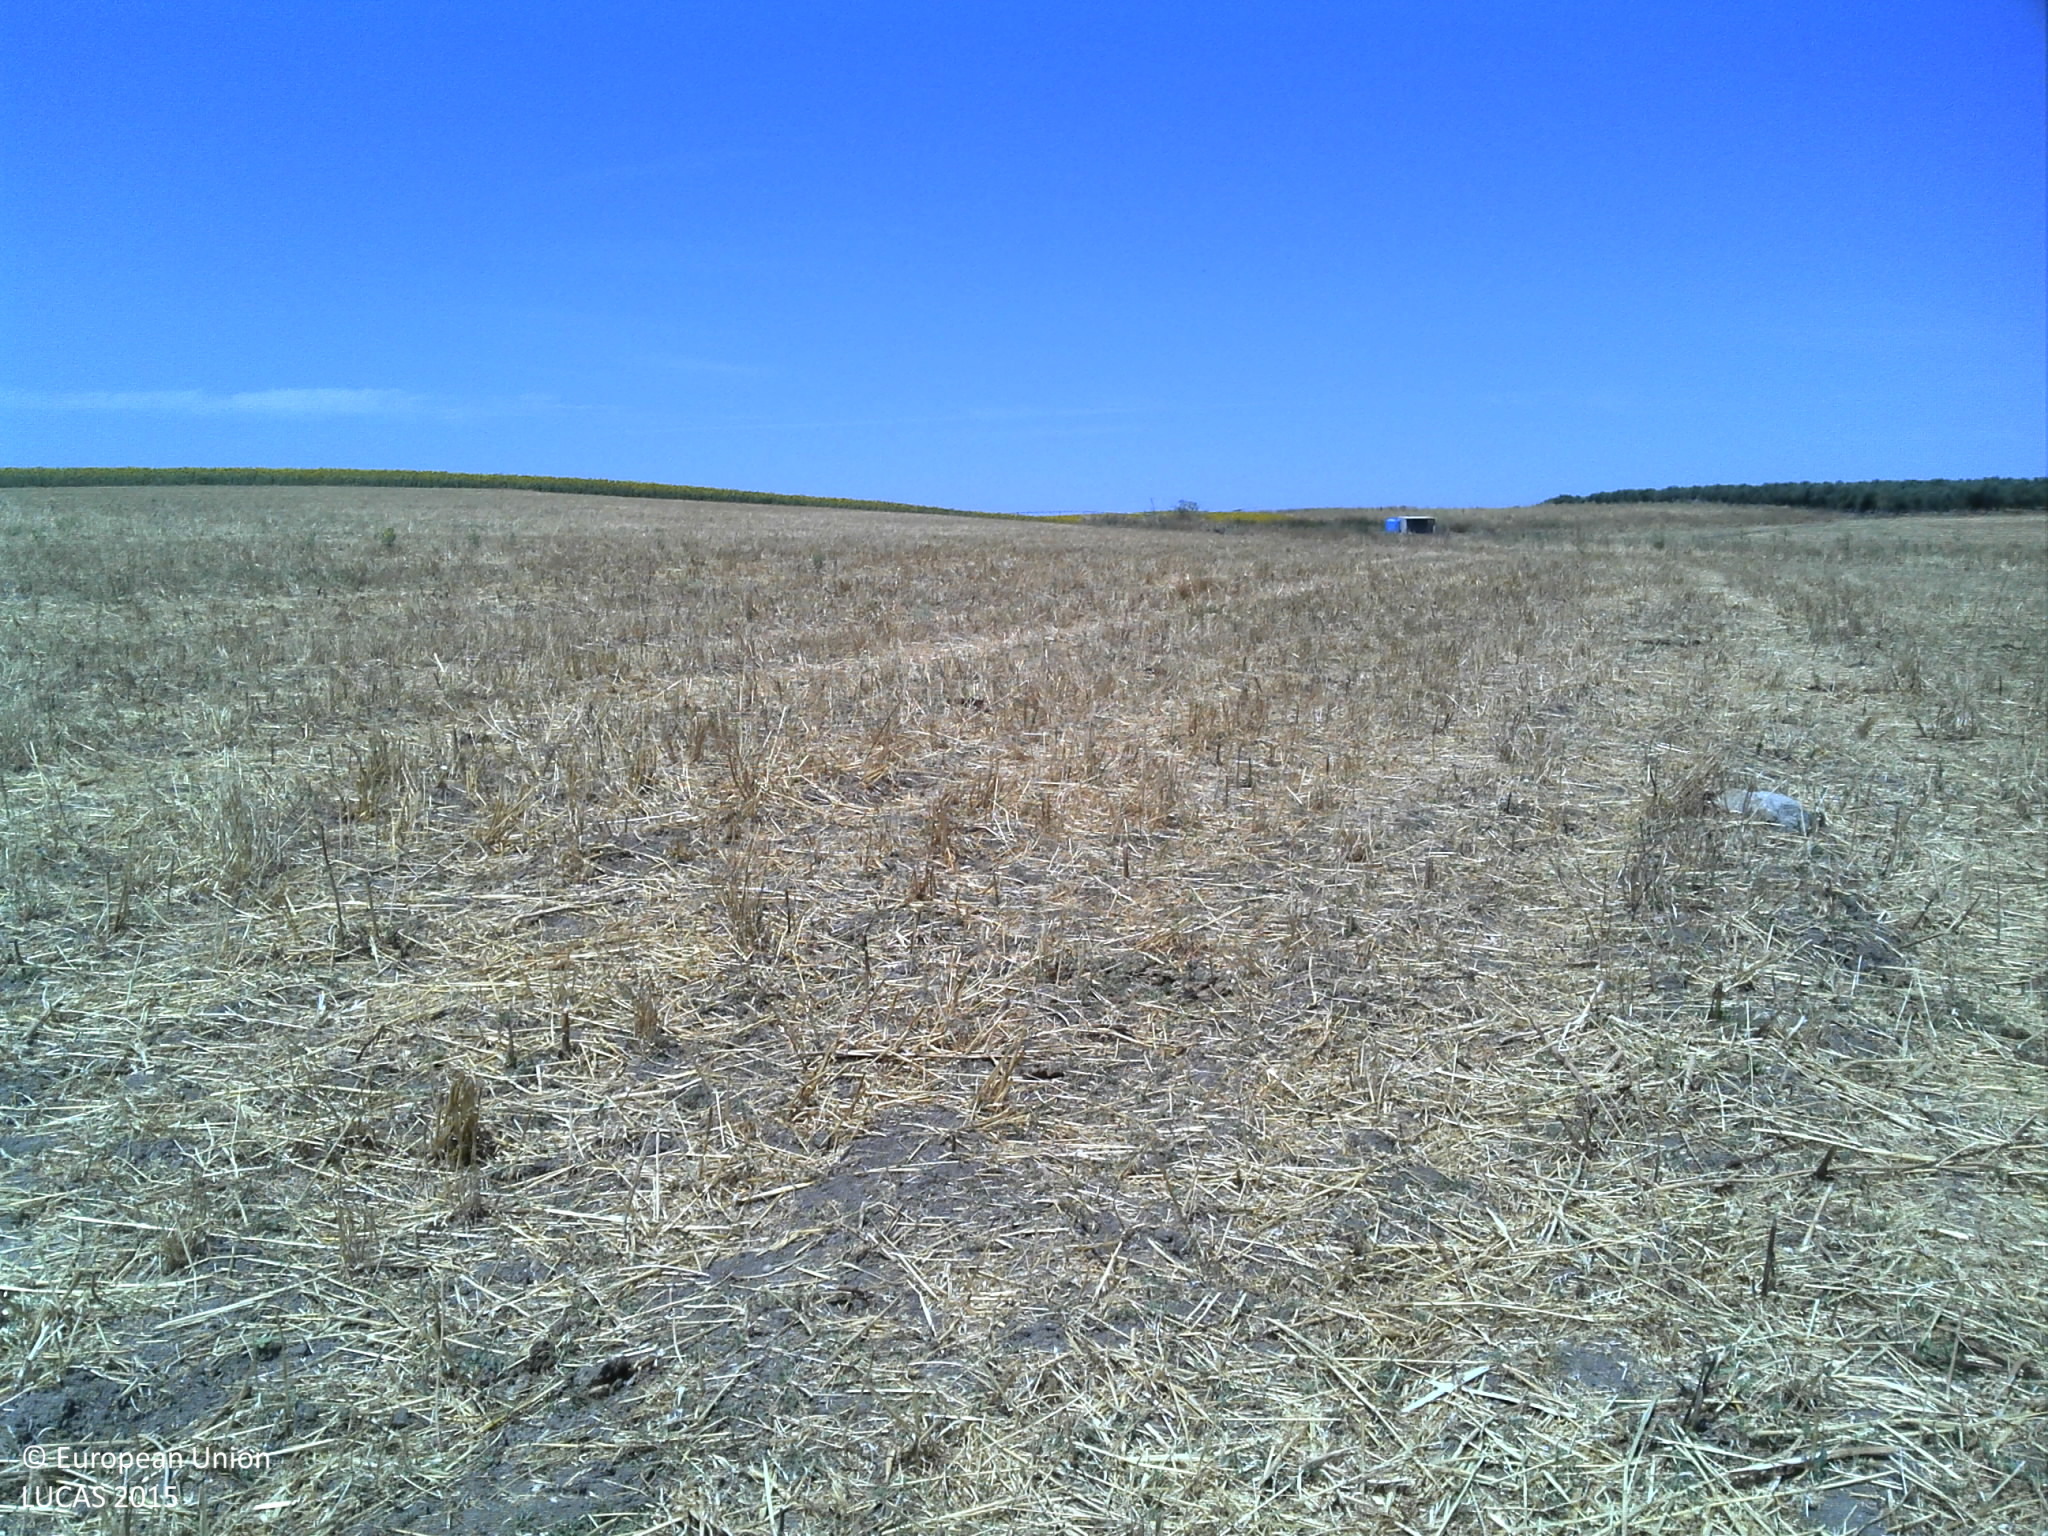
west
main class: Cropland
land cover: Common wheat
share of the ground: > 75 %
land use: Agriculture (excluding fallow land and kitchen gardens)
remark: Harvested field
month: June
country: PT
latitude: 37.9403
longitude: -7.5072
